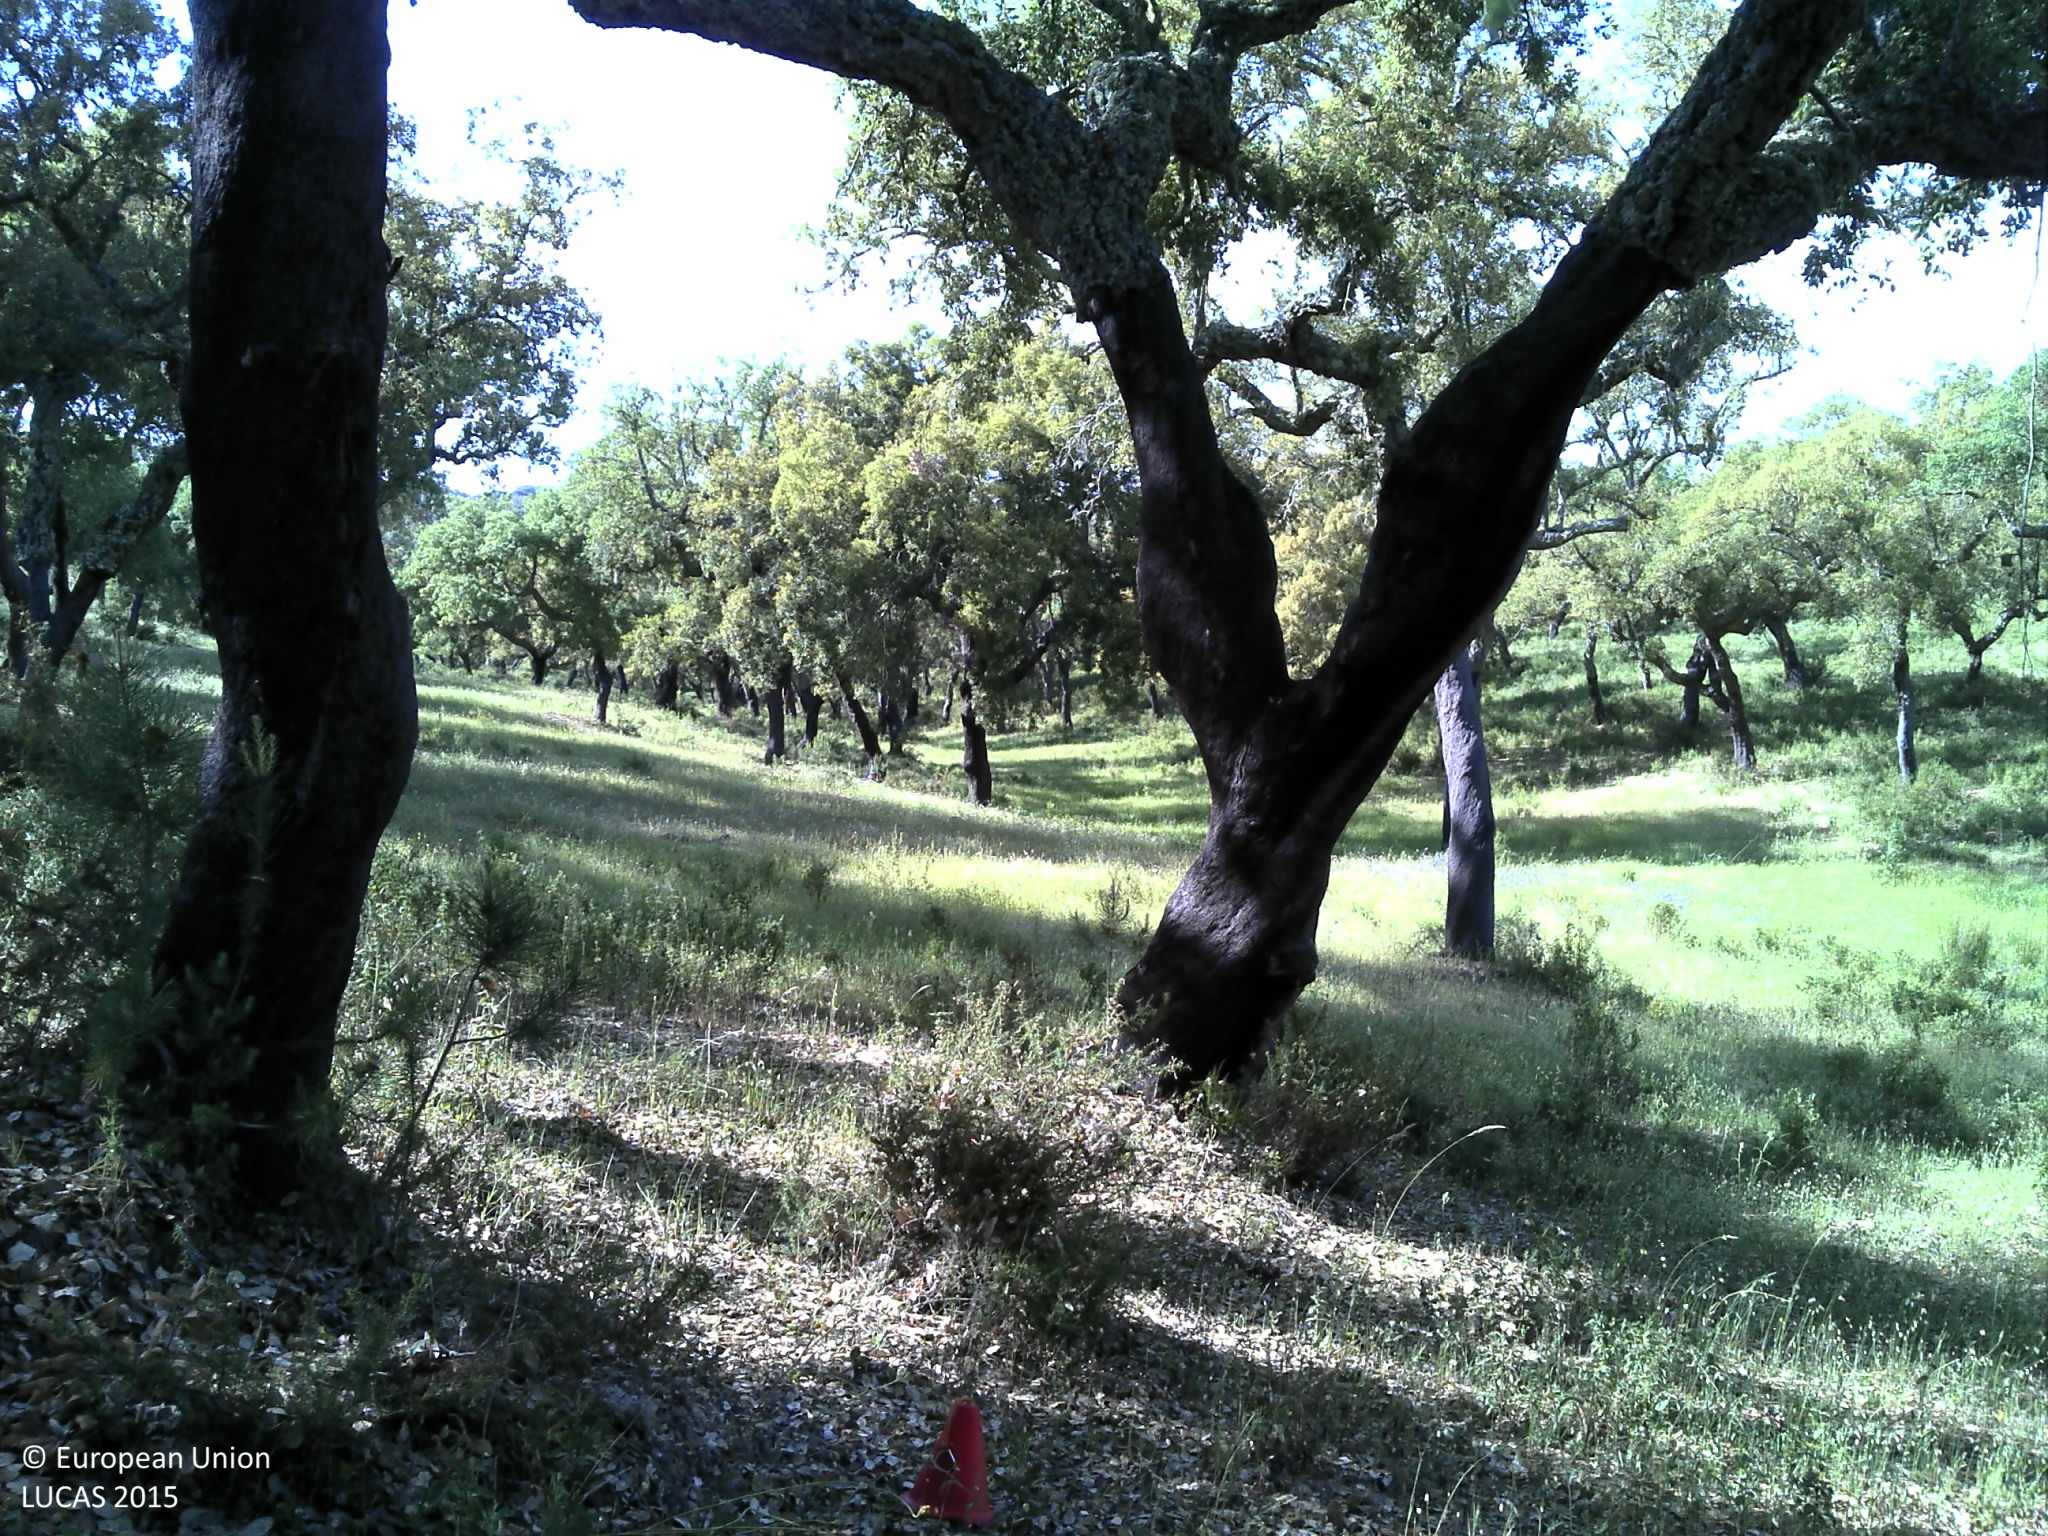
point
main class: Woodland
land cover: Broadleaved woodland
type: broadleaved evergreen forest
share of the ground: 50 - 75 %
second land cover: Grassland without tree/shrub cover
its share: 10 - 25 %
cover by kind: broadleaved forest trees 75 %, herbaceous plants 15 %, unconsolidated bare surface 10 %
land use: Forestry
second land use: Agriculture (excluding fallow land and kitchen gardens)
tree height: > 5 m
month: May
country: PT
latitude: 38.9806
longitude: -8.1656
